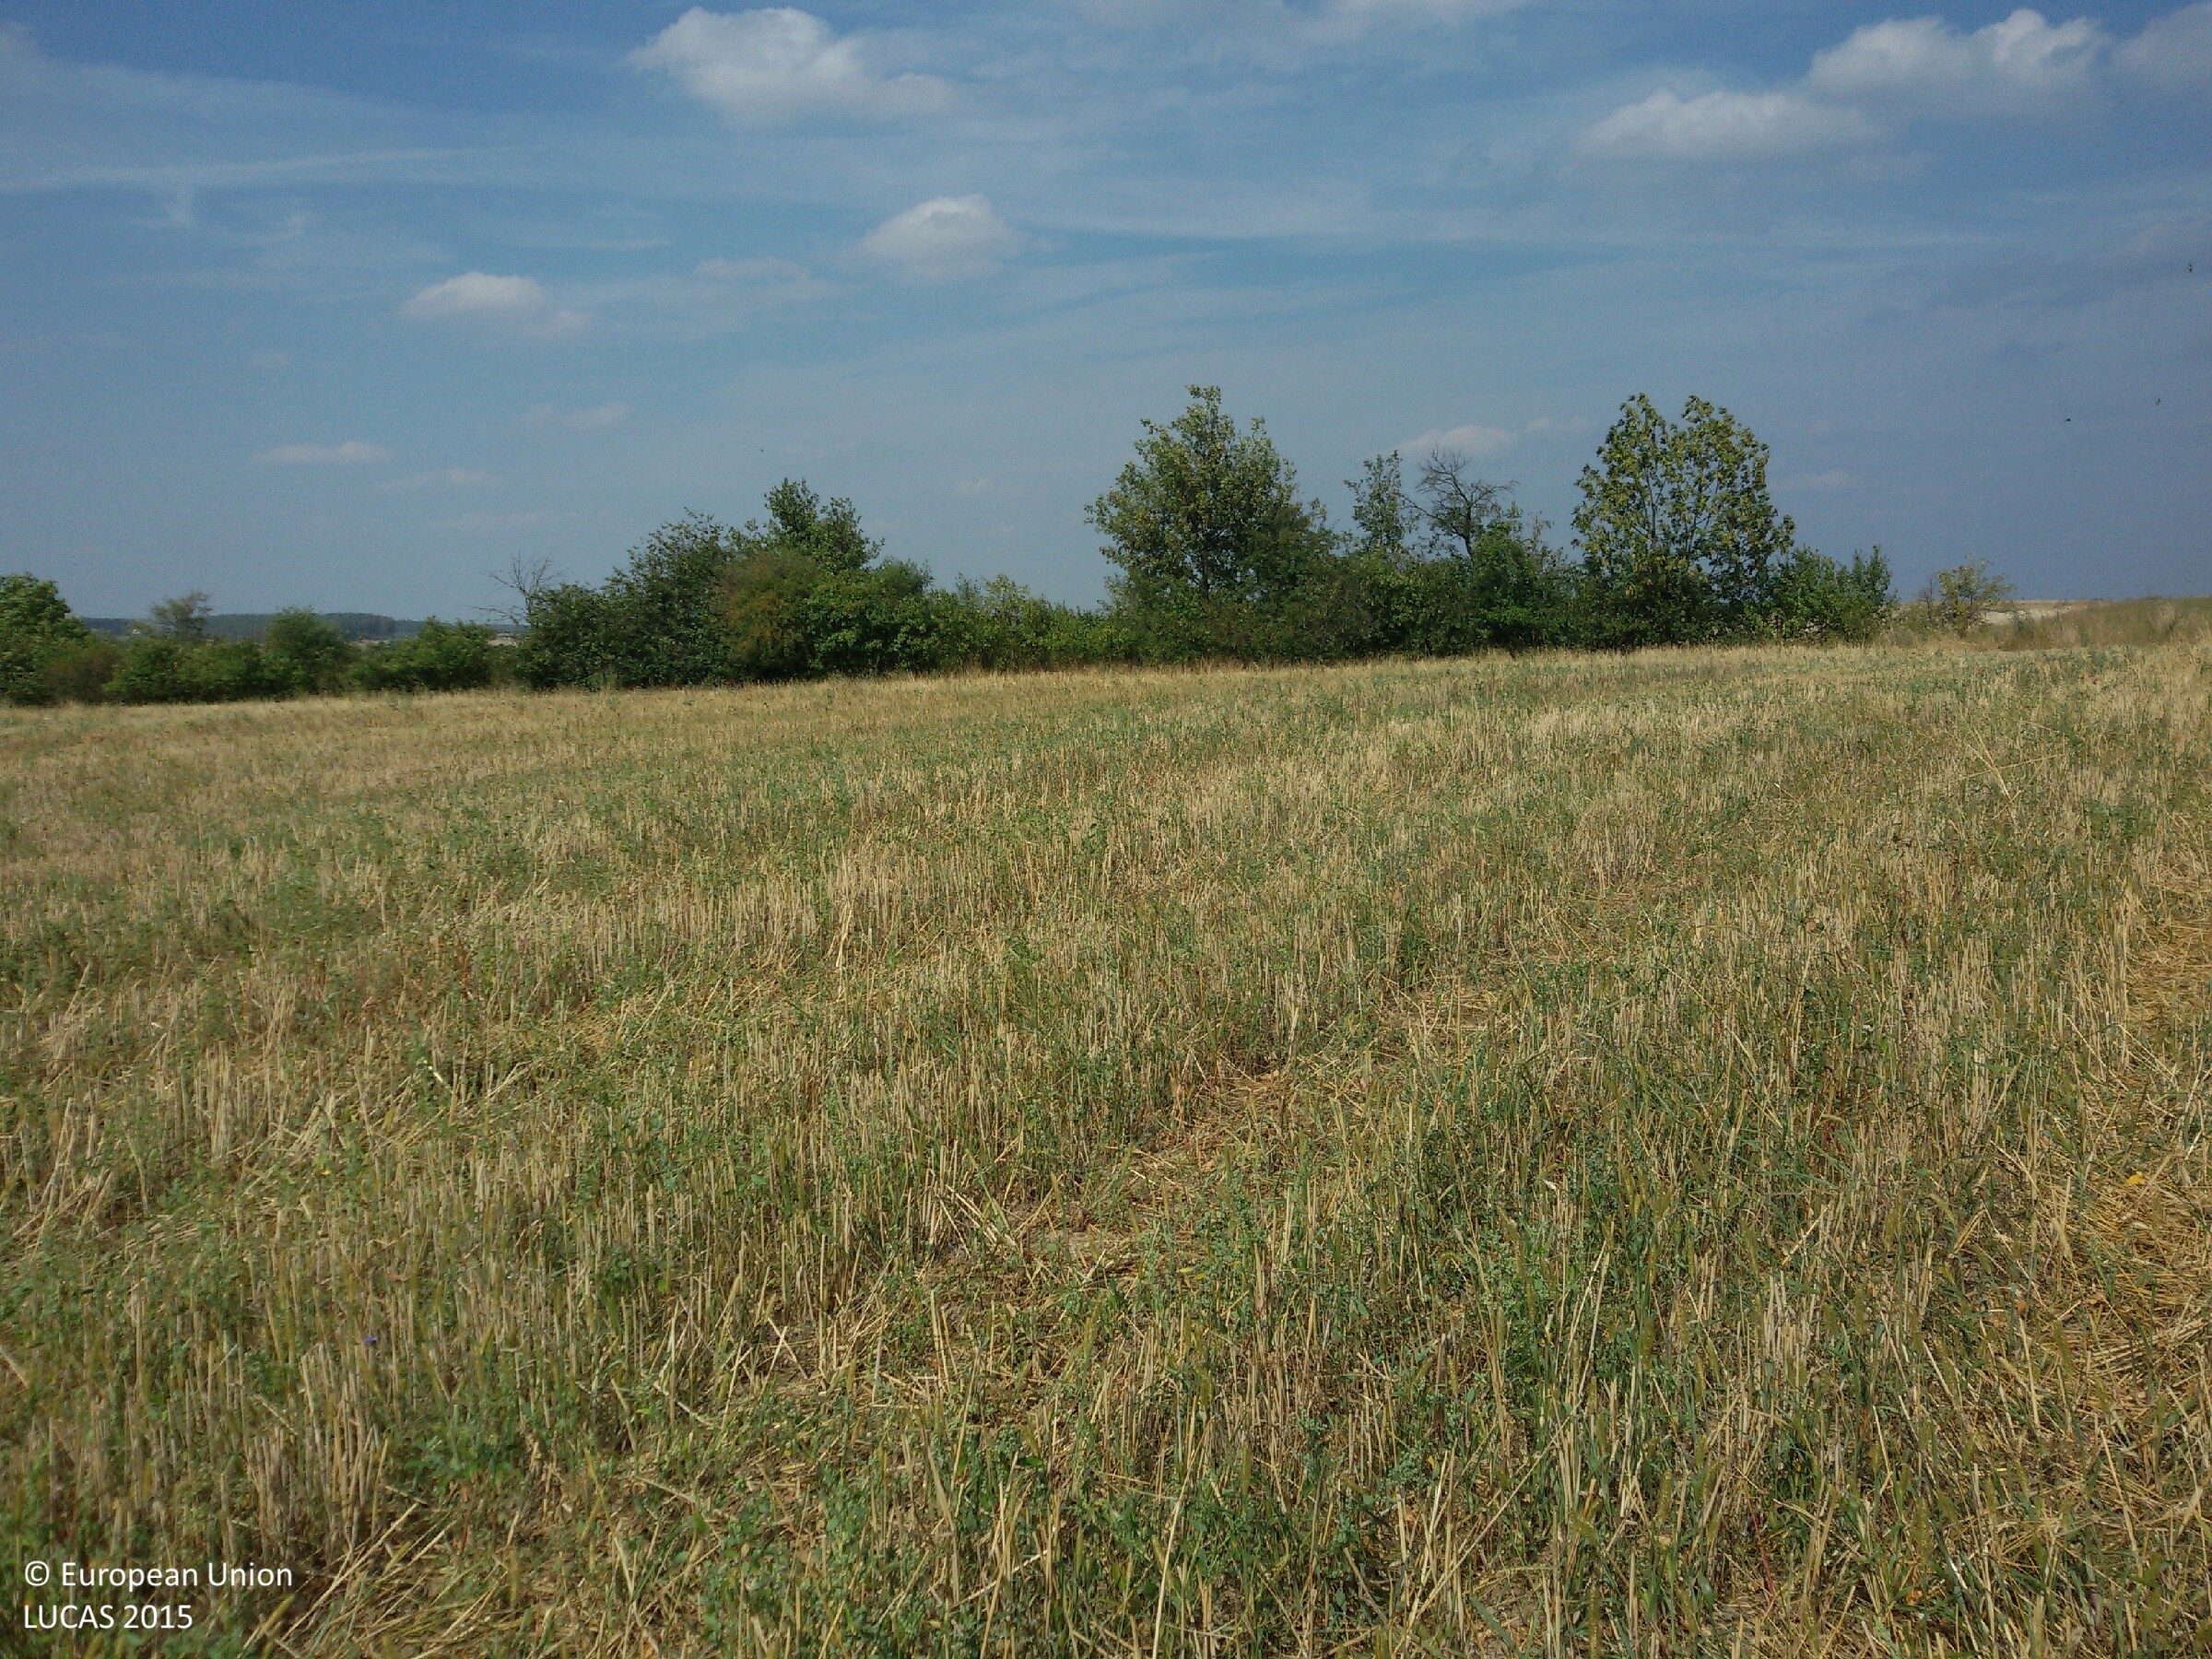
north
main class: Cropland
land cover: Rye
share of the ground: > 75 %
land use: Agriculture (excluding fallow land and kitchen gardens)
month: August
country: PL
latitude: 52.3012
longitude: 15.5621
